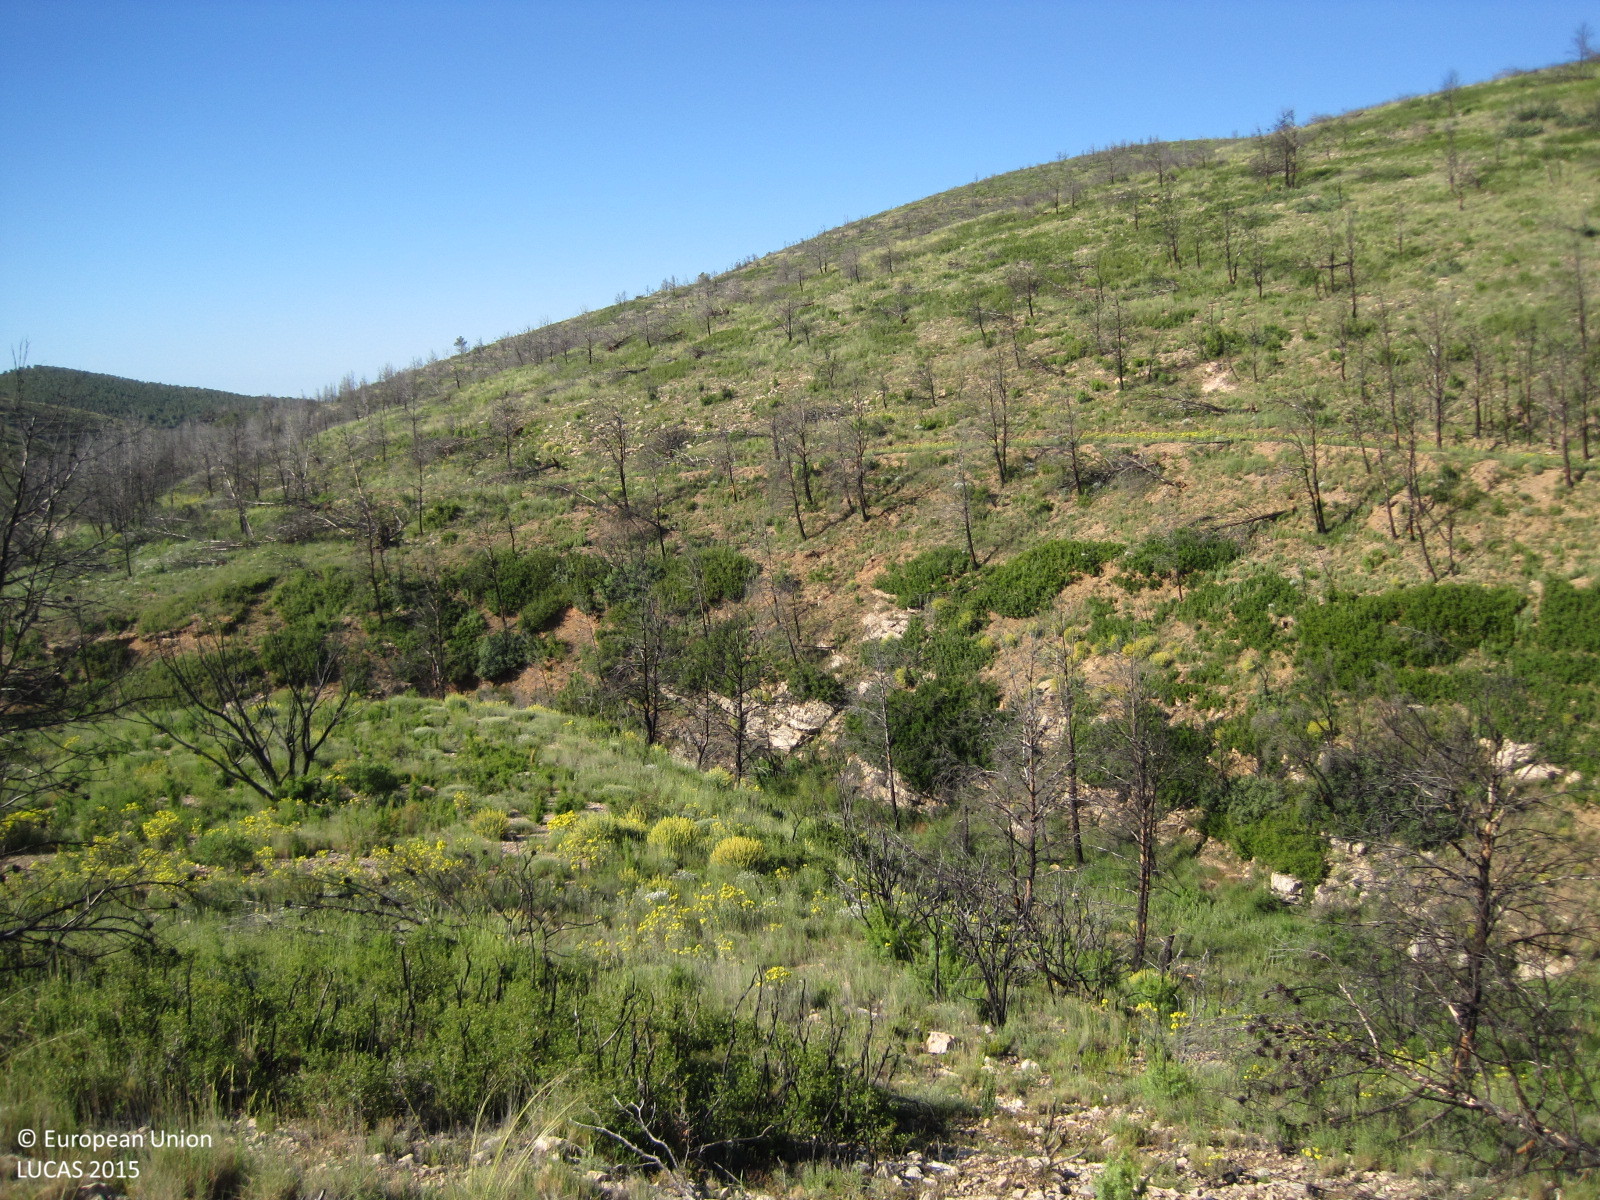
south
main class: Shrubland
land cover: Shrubland with sparse tree cover
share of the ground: 25 - 50 %
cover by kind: shrubs 40 %, herbaceous plants 35 %, consolidated bare surface 20 %, coniferous forest trees 5 %
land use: Semi-natural and natural areas not in use
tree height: < 5 m
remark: Burnt area
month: May
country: ES
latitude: 39.7708
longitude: -0.7075
